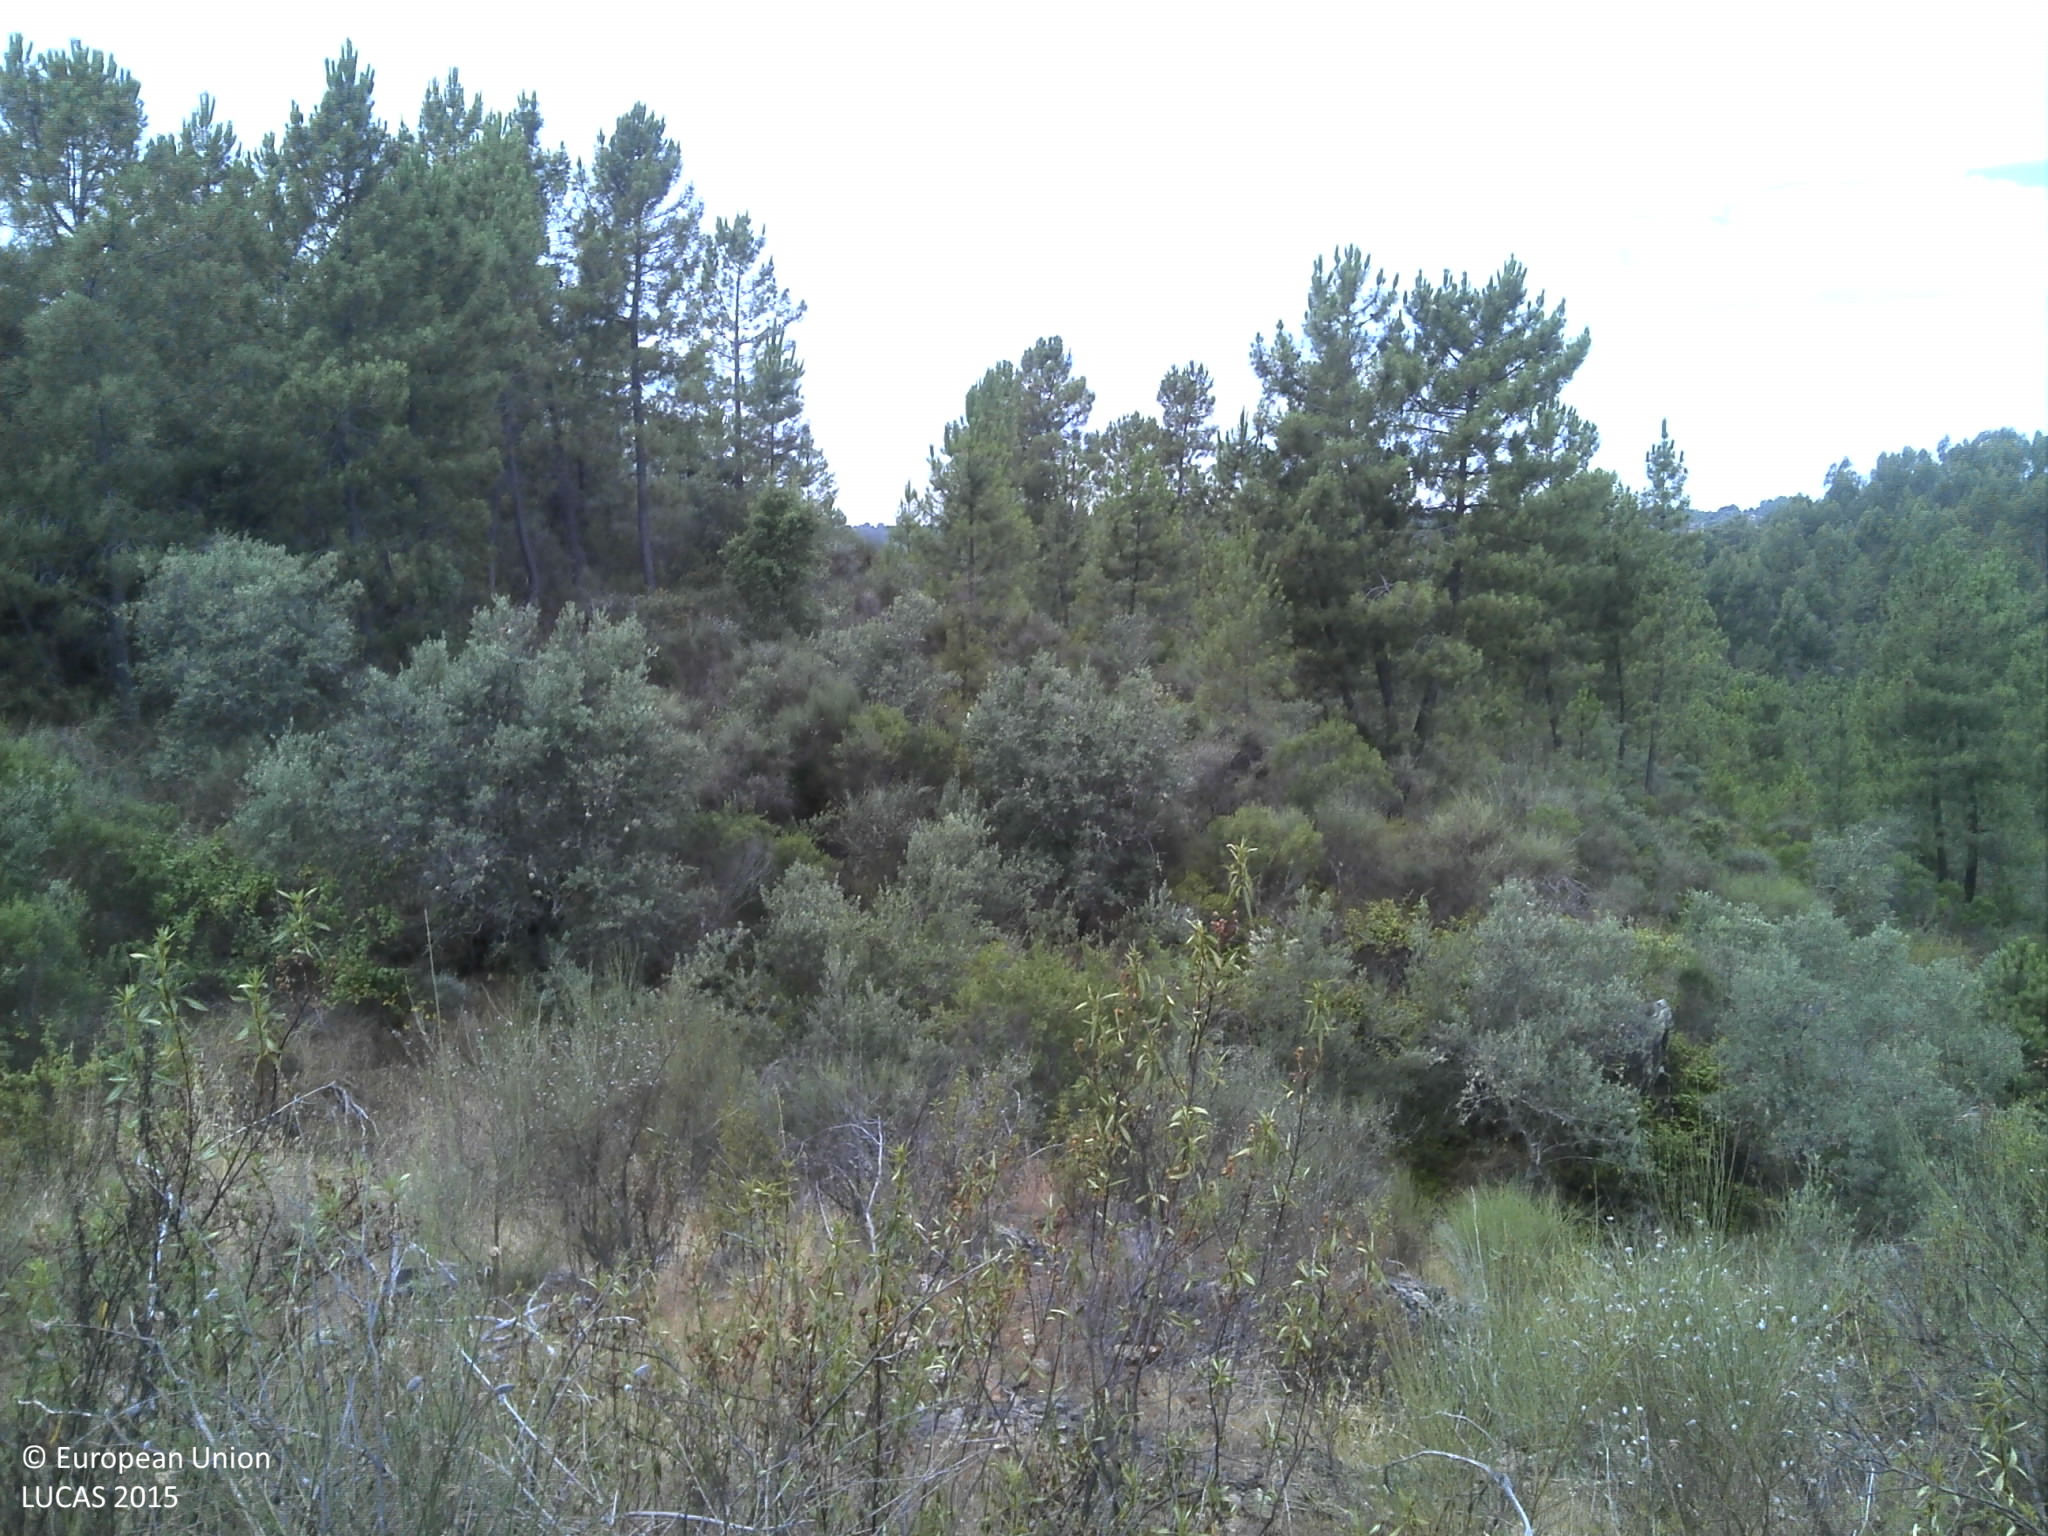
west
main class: Woodland
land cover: Pine dominated coniferous woodland
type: coniferous forest of the mediterranean region
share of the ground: 25 - 50 %
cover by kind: coniferous forest trees 45 %, shrubs 40 %, herbaceous plants 5 %, unconsolidated bare surface 5 %
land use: Forestry
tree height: > 5 m
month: July
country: PT
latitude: 39.8465
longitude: -7.3820
